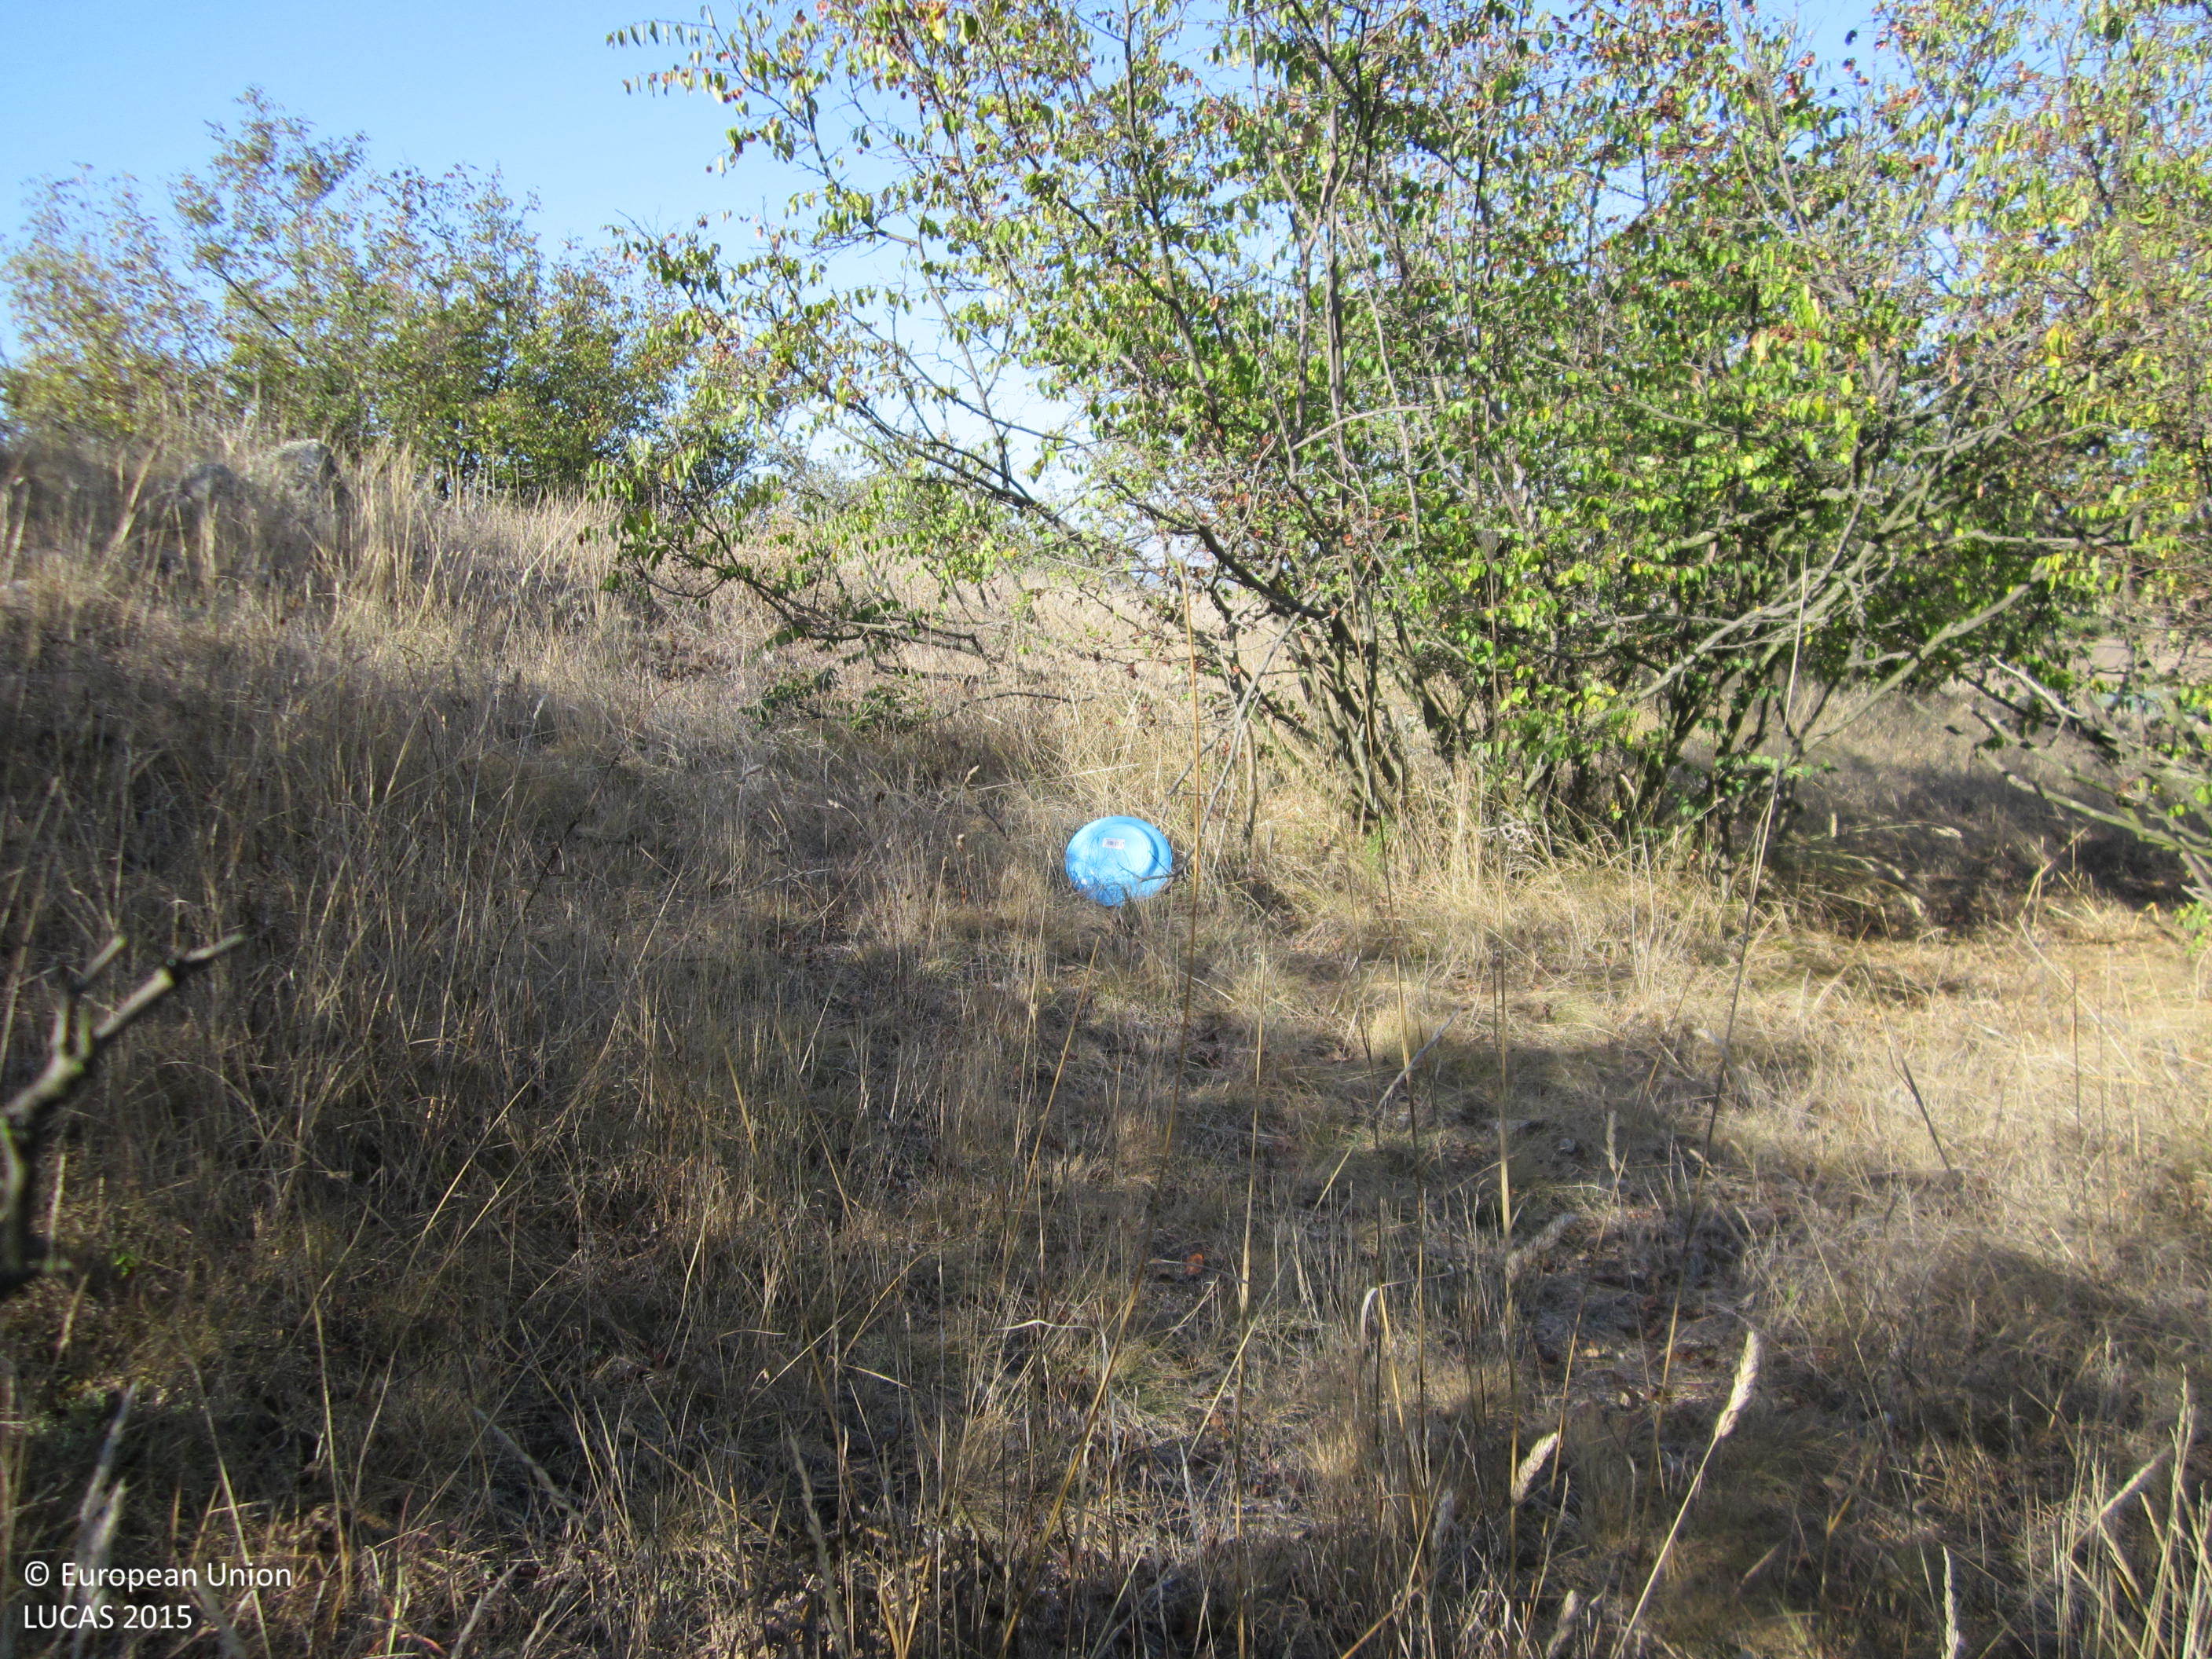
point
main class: Shrubland
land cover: Shrubland without tree cover
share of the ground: 50 - 75 %
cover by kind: shrubs 70 %, herbaceous plants 30 %
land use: Agriculture (excluding fallow land and kitchen gardens)
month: September
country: BG
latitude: 42.6528
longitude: 27.2518
